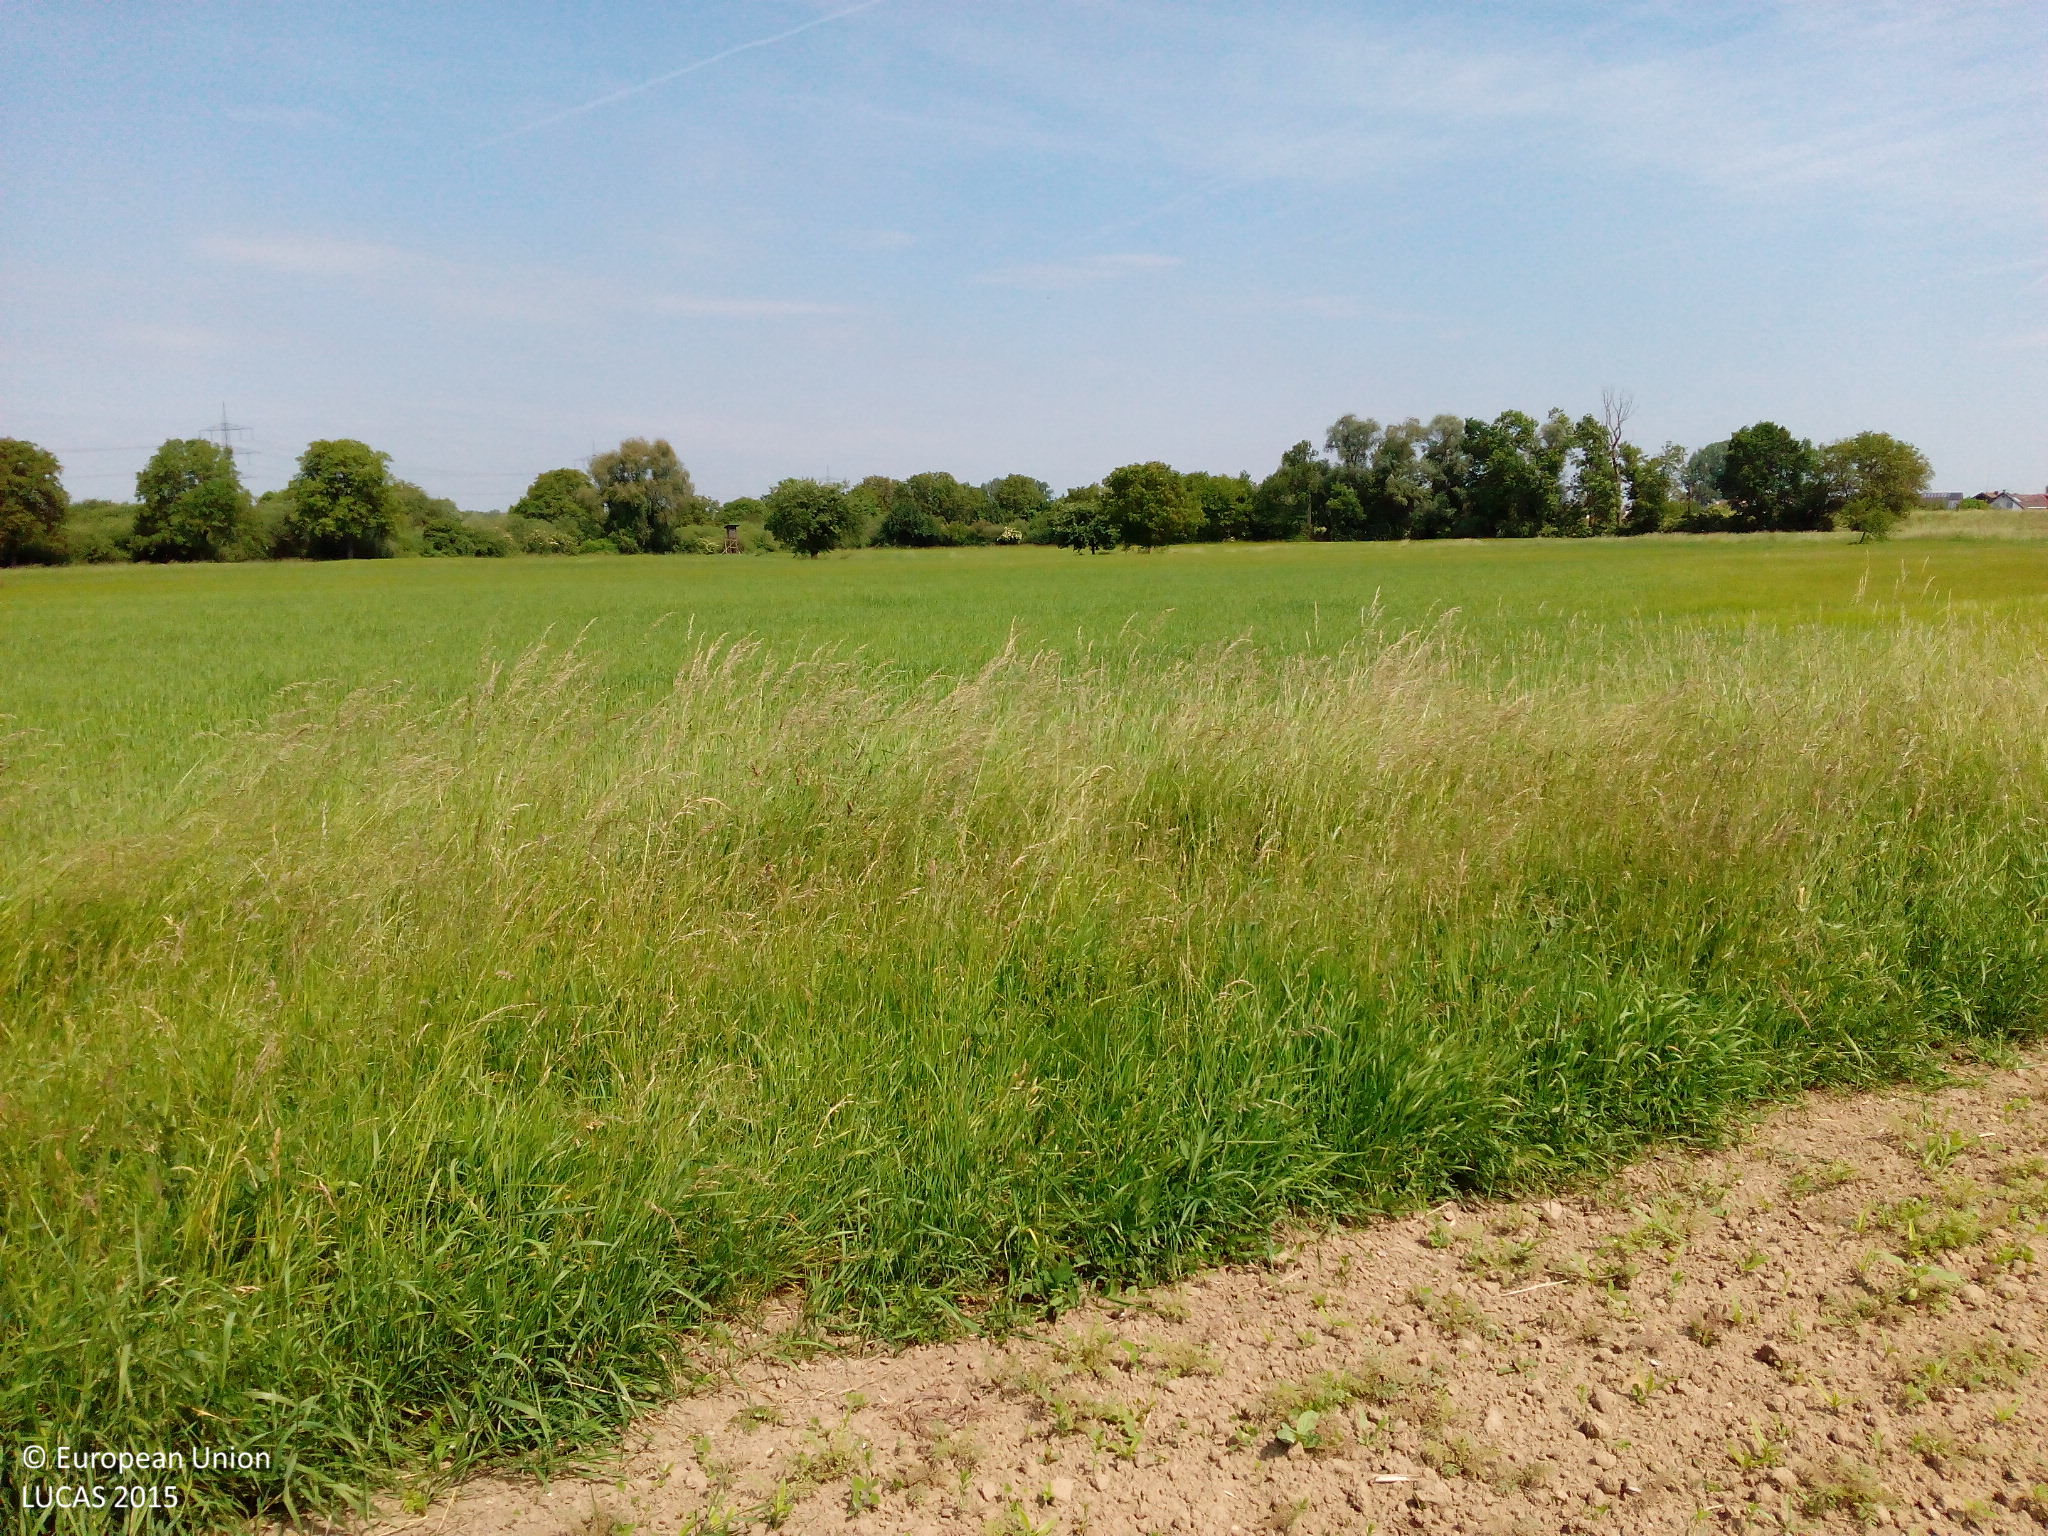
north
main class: Cropland
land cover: Other leguminous and mixtures for fodder
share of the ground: < 10 %
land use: Agriculture (excluding fallow land and kitchen gardens)
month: May
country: DE
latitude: 48.8925
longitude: 8.1866
